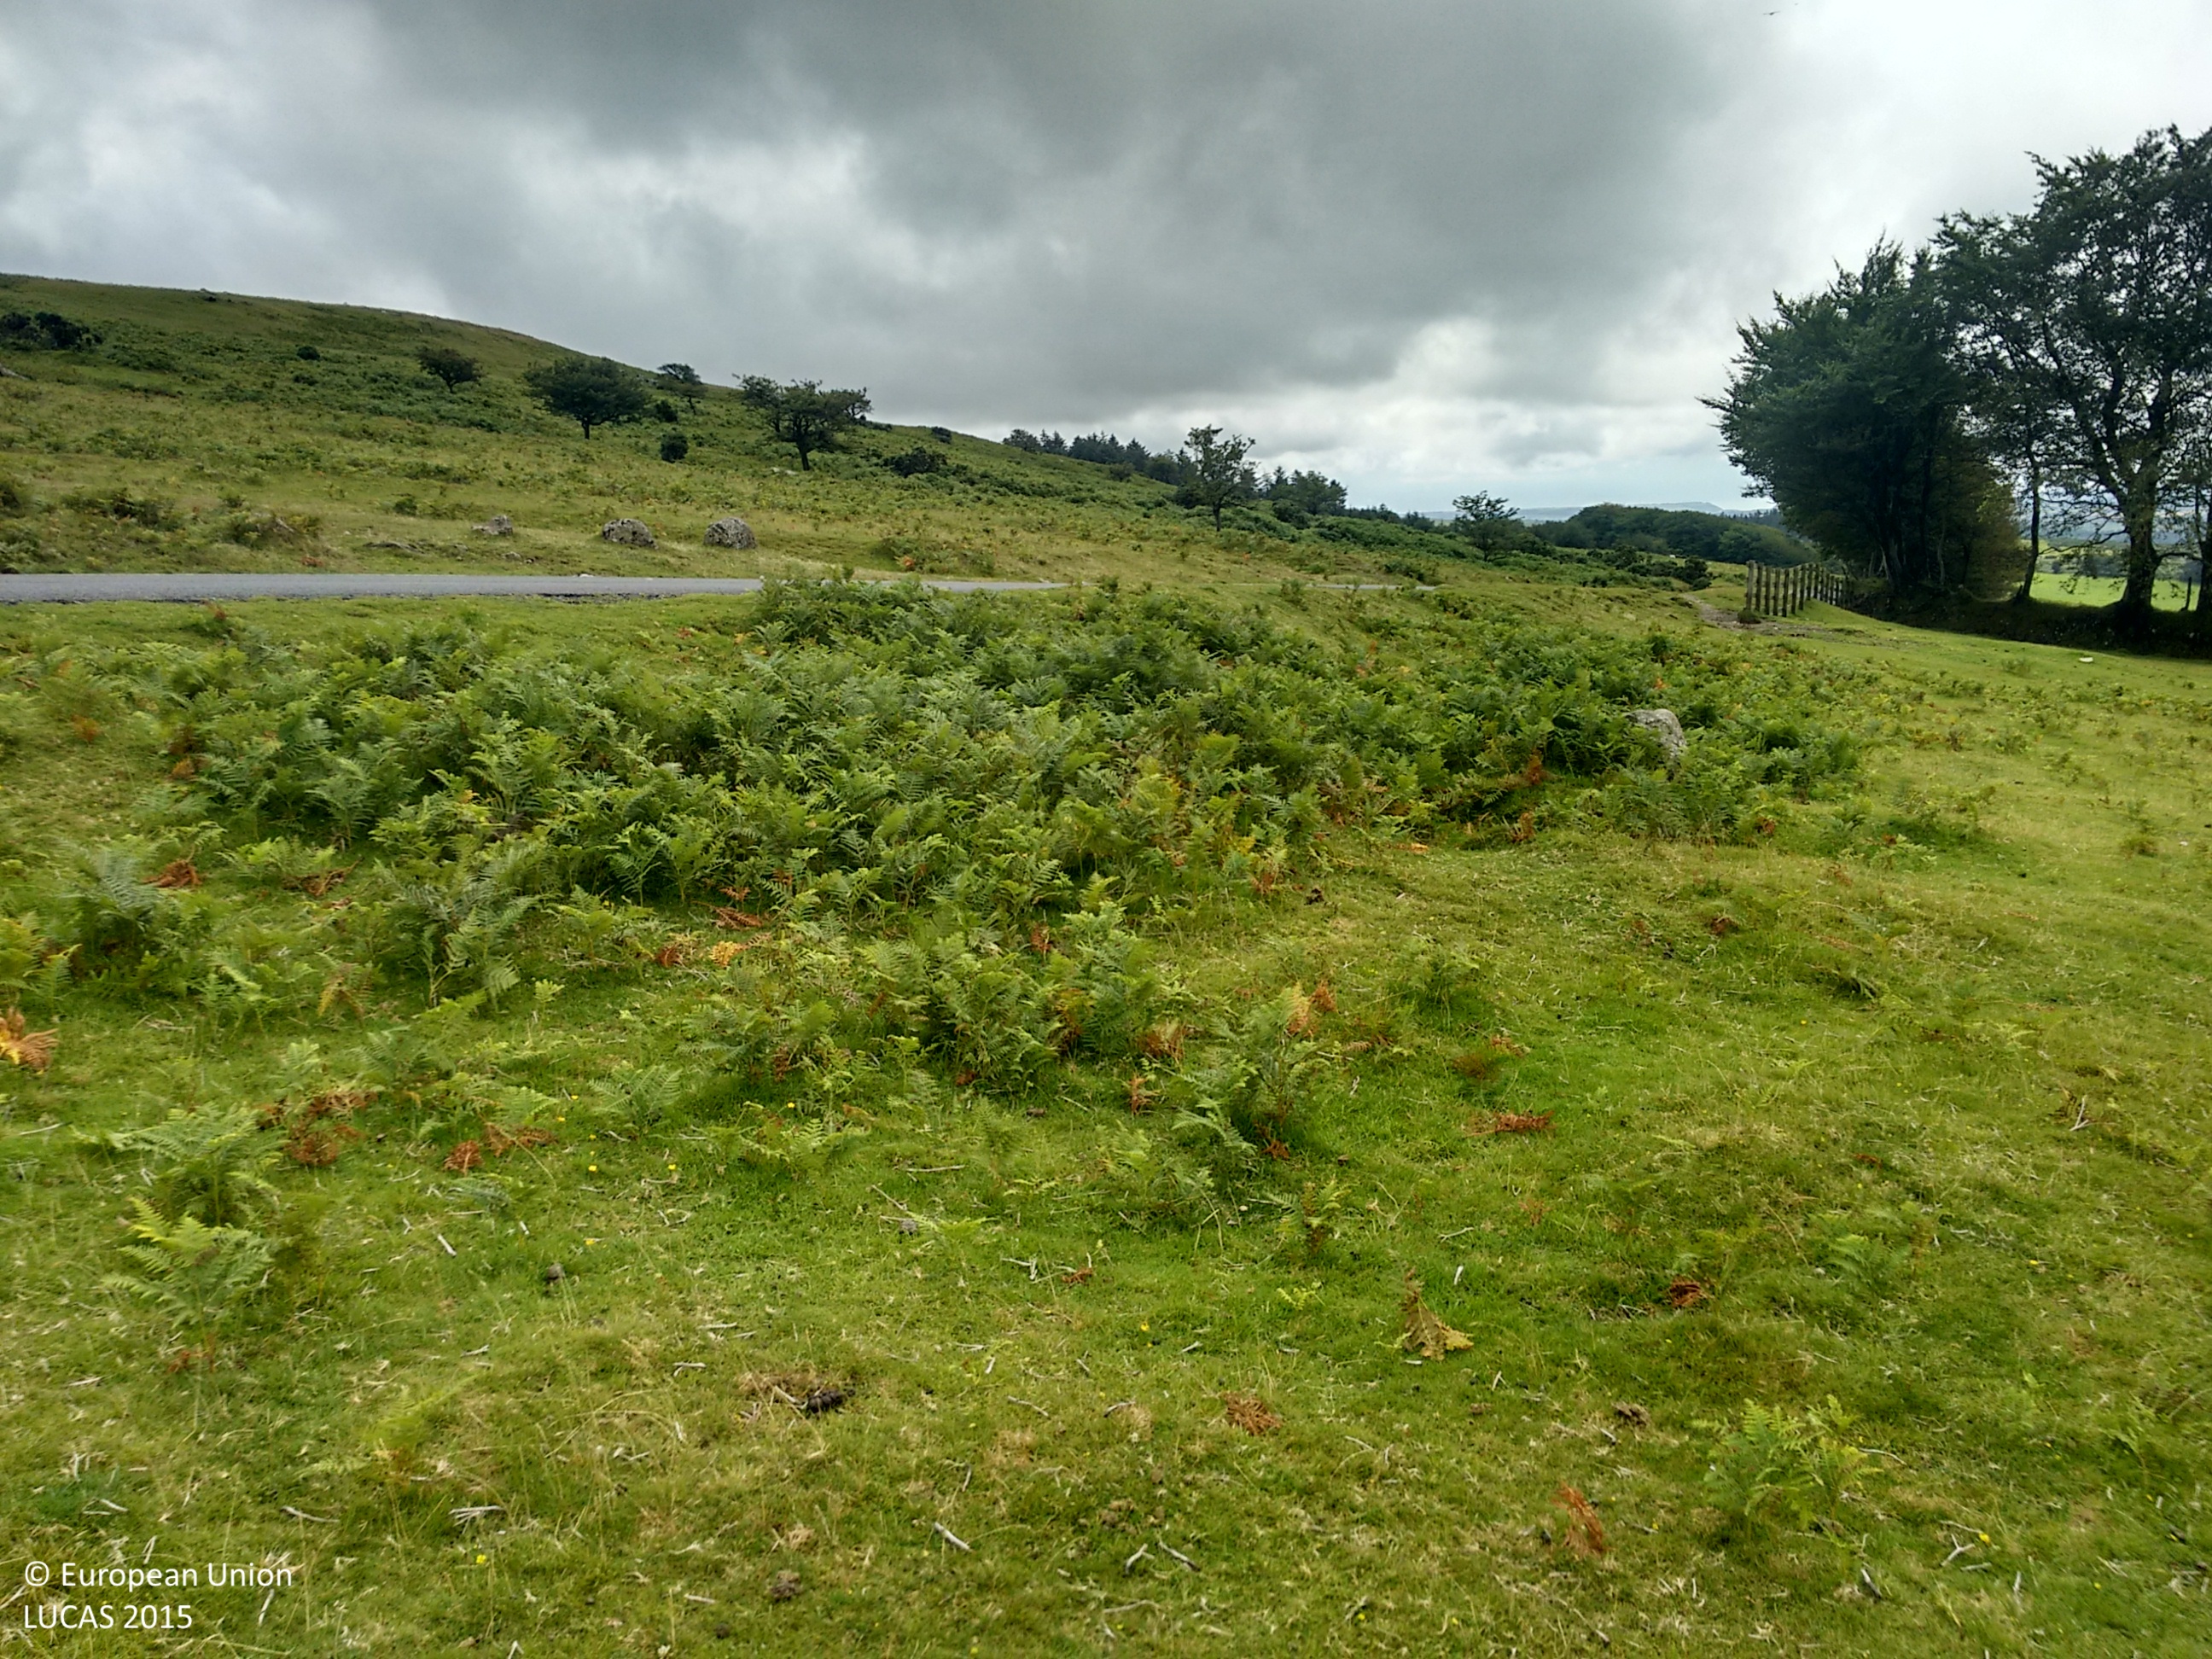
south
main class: Grassland
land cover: Grassland without tree/shrub cover
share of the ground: > 75 %
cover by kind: herbaceous plants 100 %
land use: Agriculture (excluding fallow land and kitchen gardens)
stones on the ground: < 10 %
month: August
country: GB
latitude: 50.5146
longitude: -4.0421
